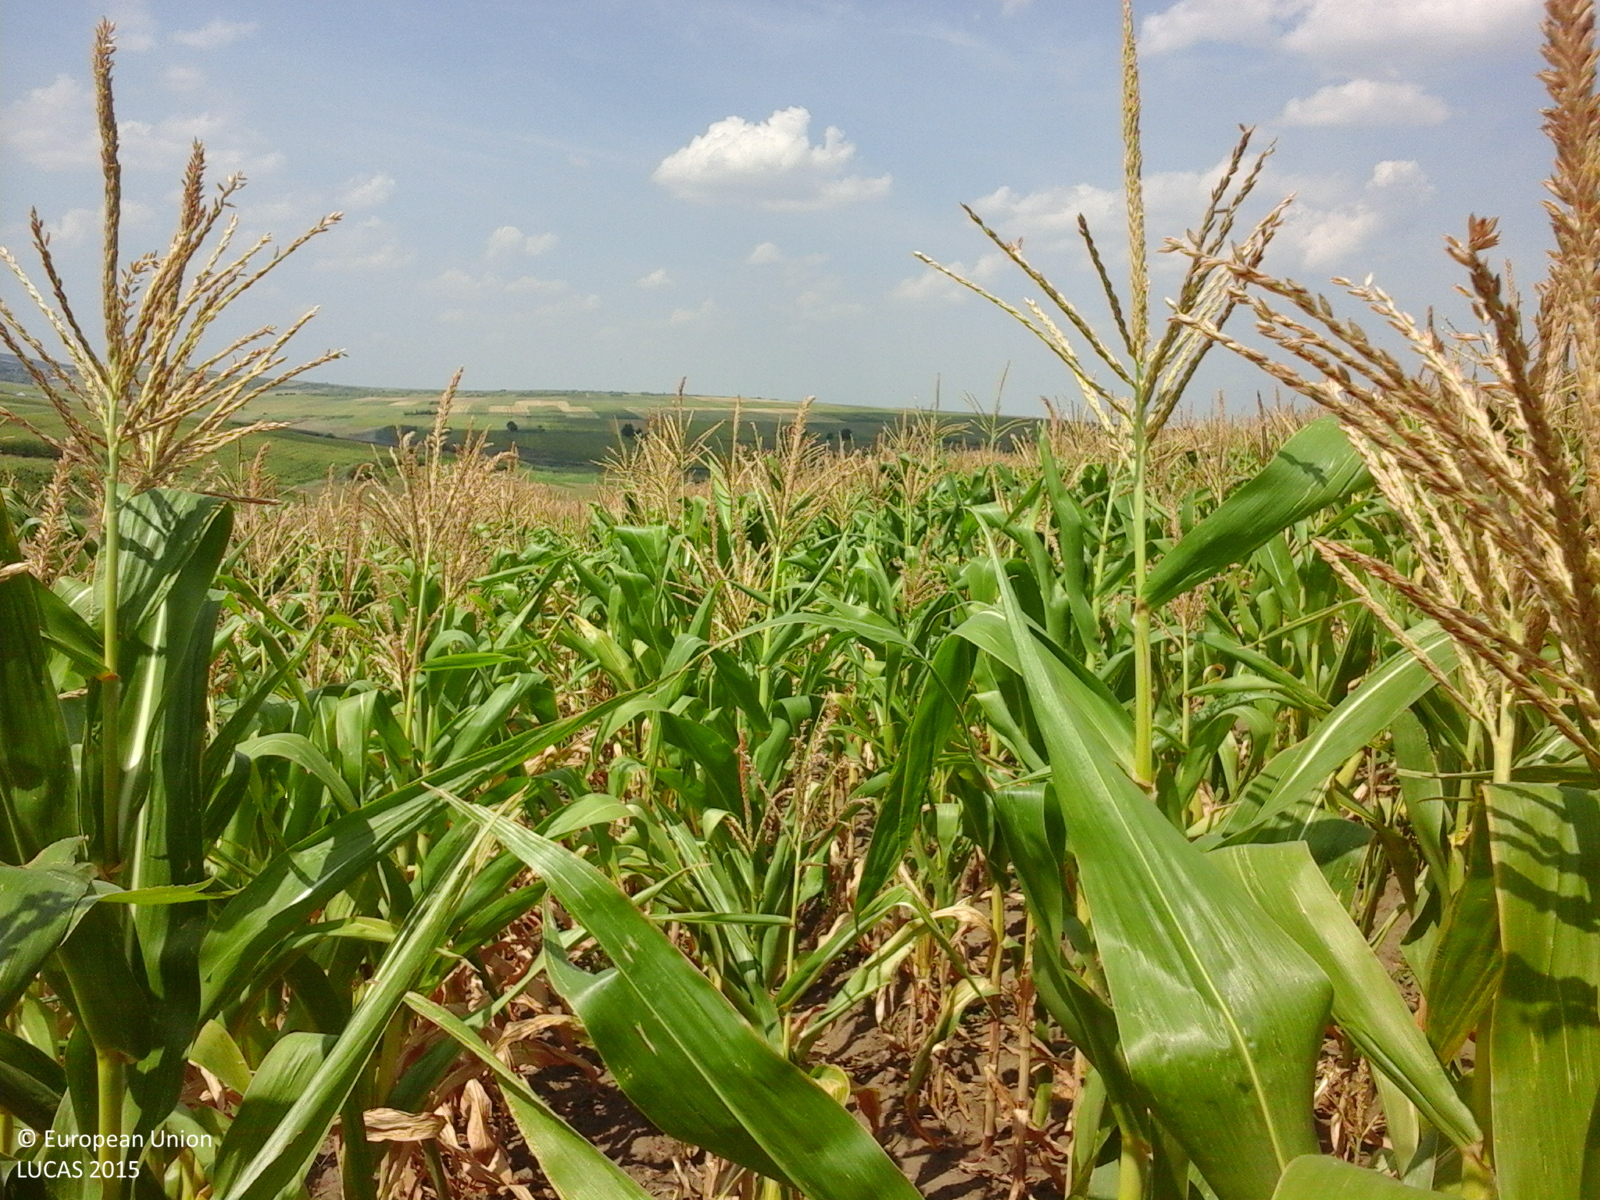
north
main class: Cropland
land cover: Maize
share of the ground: > 75 %
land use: Agriculture (excluding fallow land and kitchen gardens)
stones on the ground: < 10 %
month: July
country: RO
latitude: 46.5879
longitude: 28.1561
